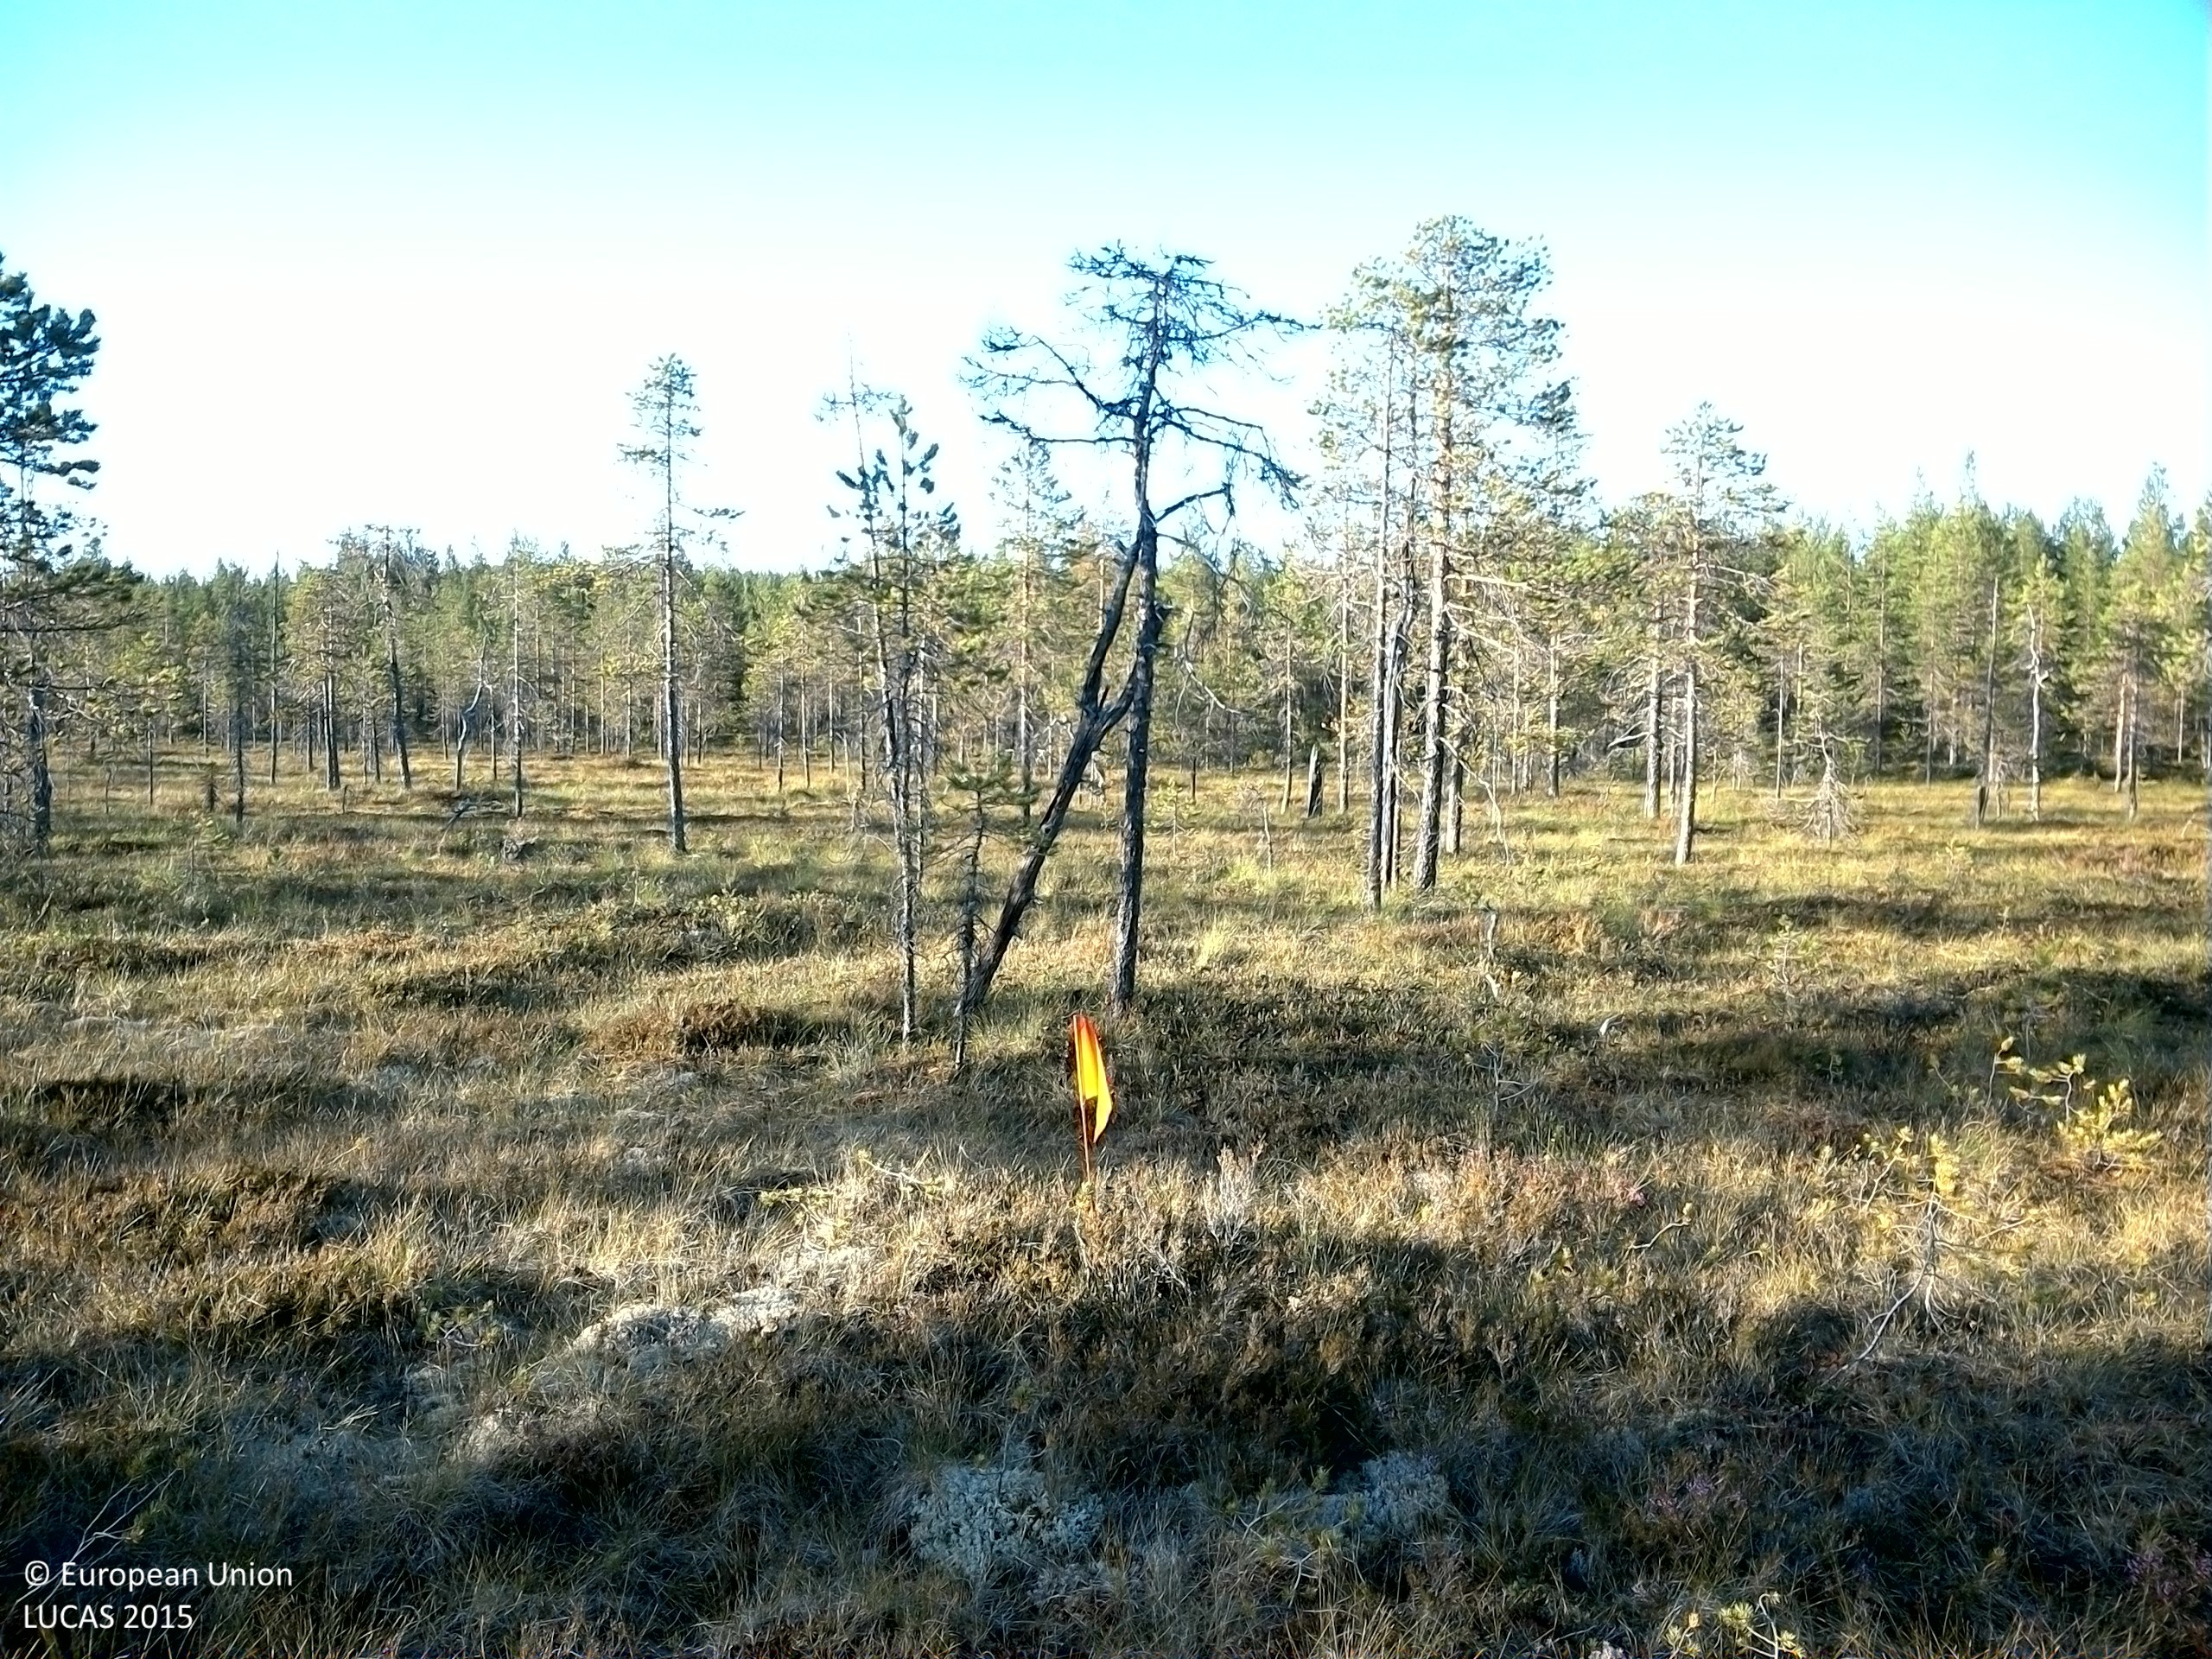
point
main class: Woodland
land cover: Pine dominated coniferous woodland
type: boreal forest
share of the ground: 10 - 25 %
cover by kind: shrubs 50 %, lichens and mosses 25 %, coniferous forest trees 15 %, herbaceous plants 10 %
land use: Semi-natural and natural areas not in use
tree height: < 5 m
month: August
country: SE
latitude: 63.6857
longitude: 18.0410
